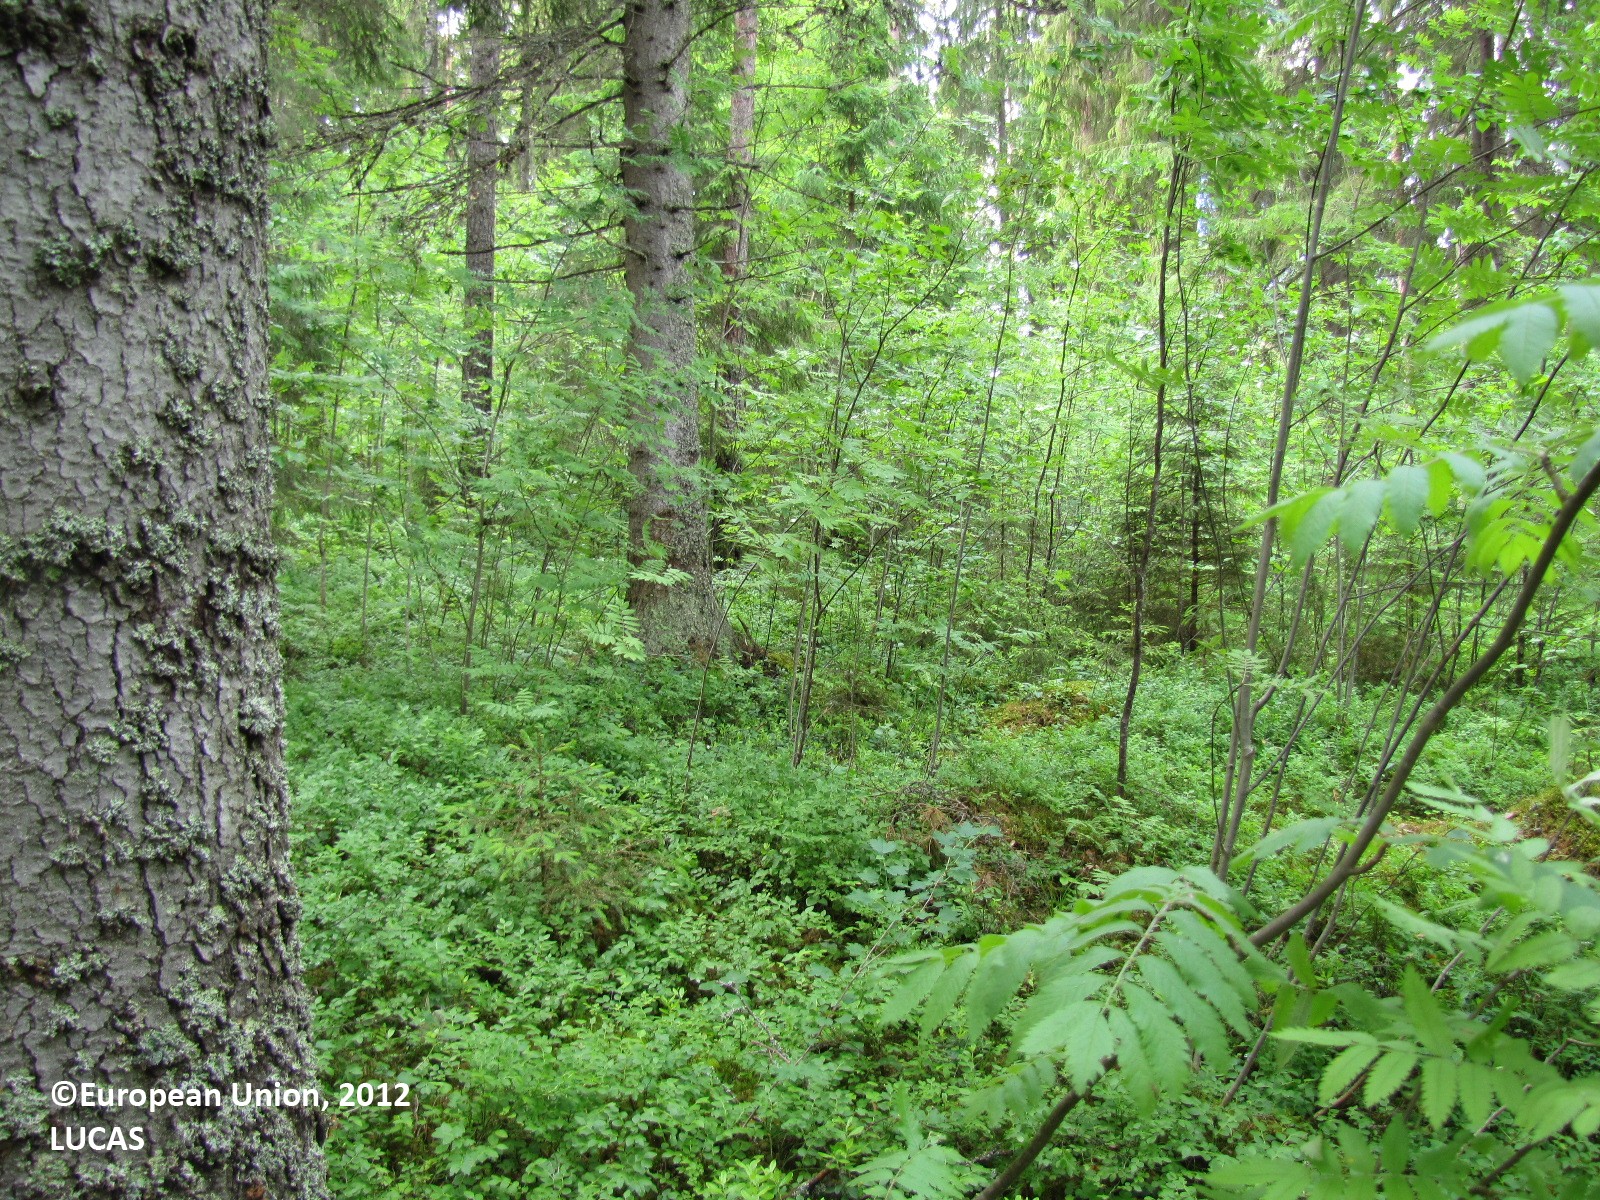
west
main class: Woodland
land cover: Spruce dominated coniferous woodland
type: boreal forest
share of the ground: > 75 %
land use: Forestry
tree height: > 5 m
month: June
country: FI
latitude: 61.2984
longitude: 24.6823
